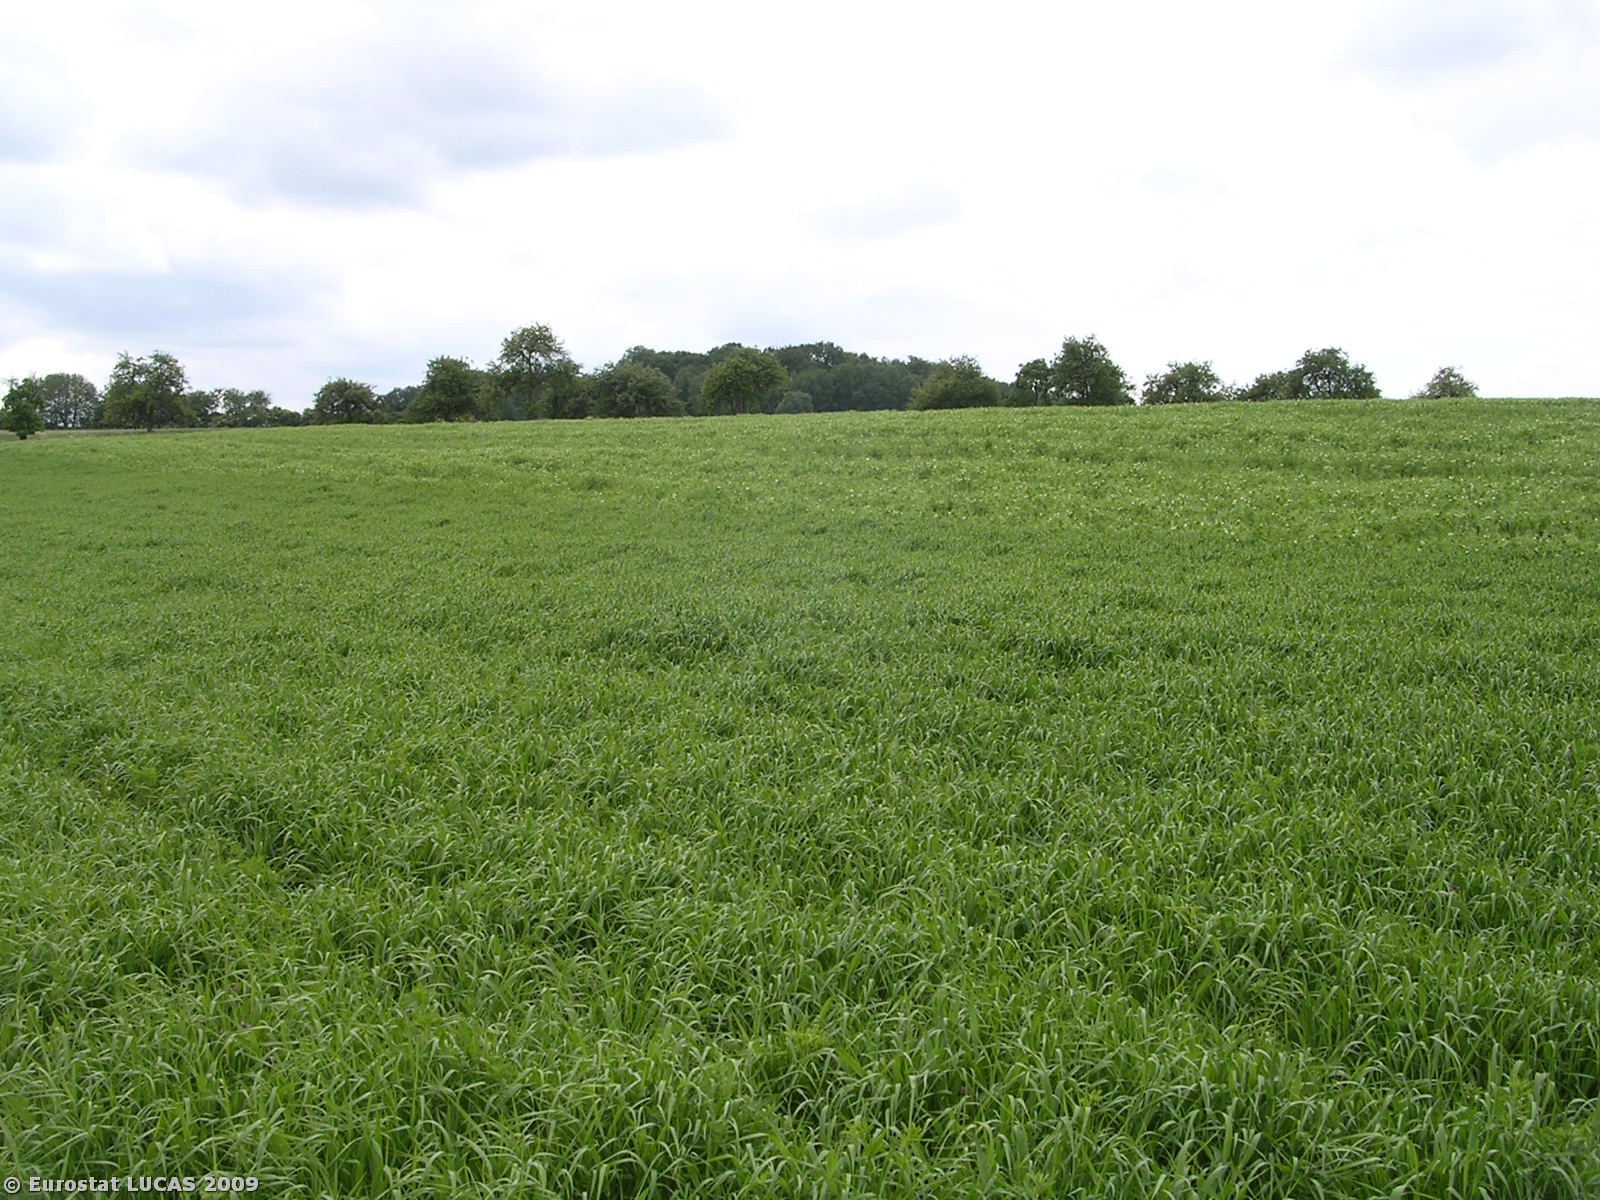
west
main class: Cropland
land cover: Barley
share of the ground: > 75 %
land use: Agriculture (excluding fallow land and kitchen gardens)
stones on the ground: < 10 %
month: June
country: CZ
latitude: 50.4827
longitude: 14.7234
